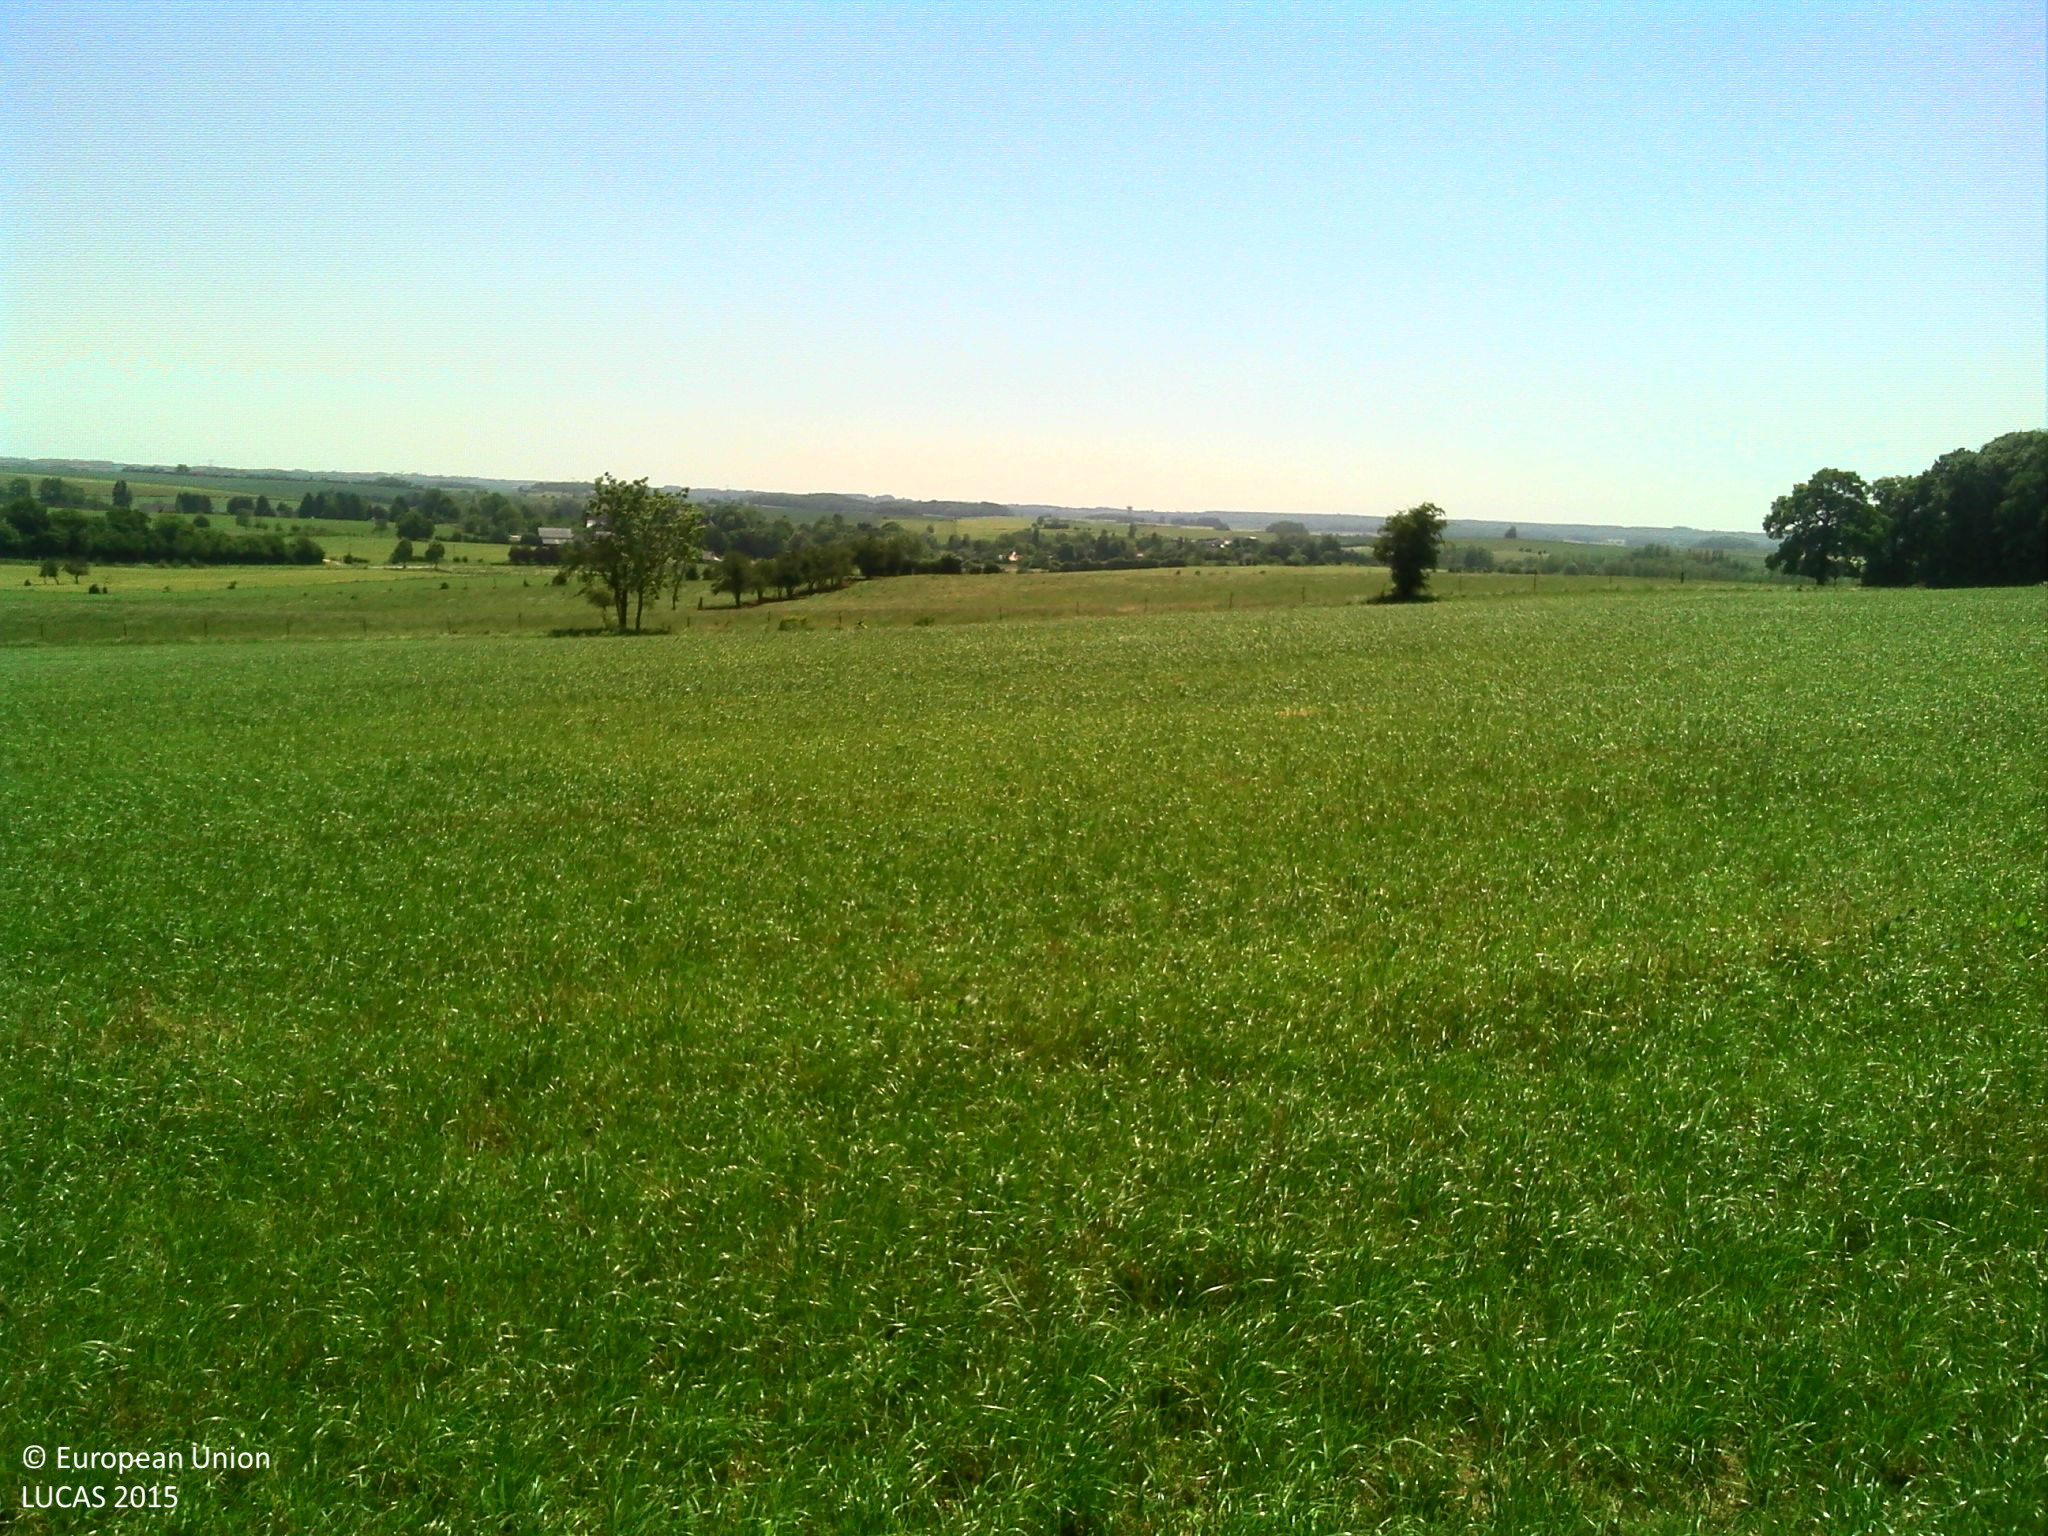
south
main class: Cropland
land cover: Temporary grasslands
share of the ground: > 75 %
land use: Agriculture (excluding fallow land and kitchen gardens)
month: June
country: FR
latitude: 49.8933
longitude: 4.2183
